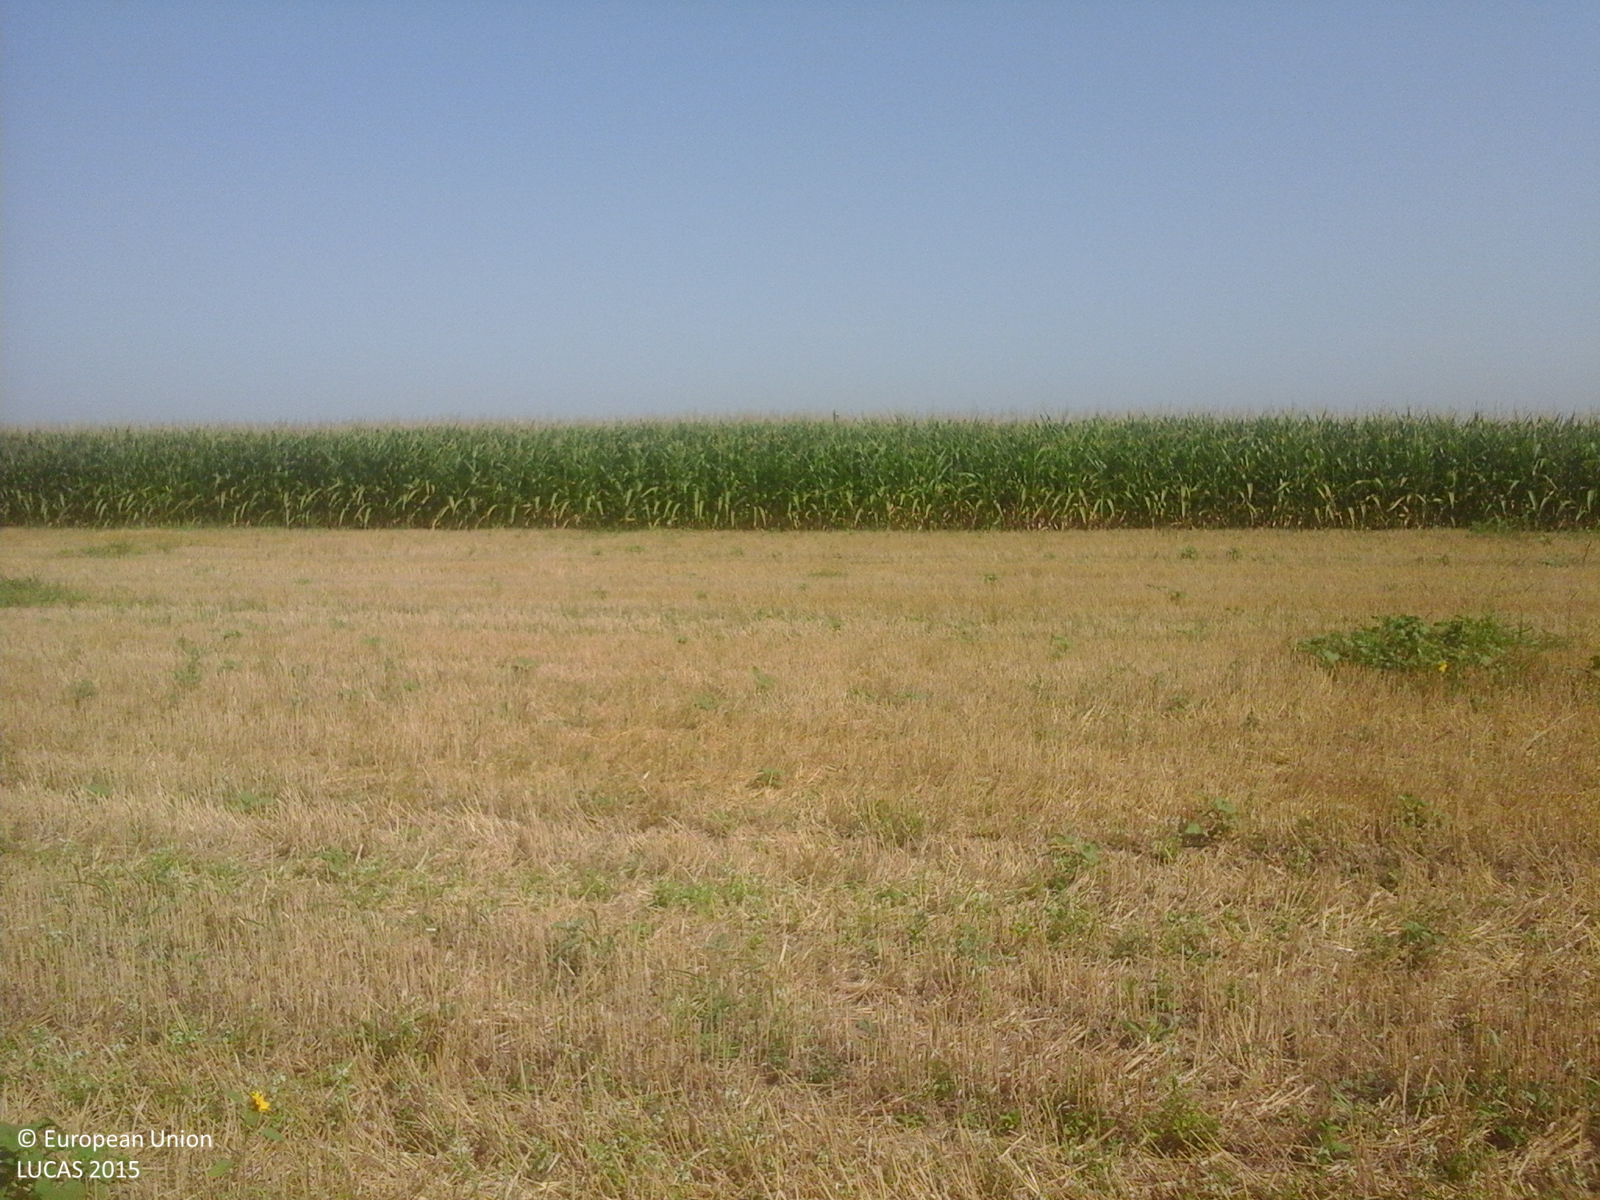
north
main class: Cropland
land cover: Maize
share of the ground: > 75 %
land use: Agriculture (excluding fallow land and kitchen gardens)
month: August
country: RO
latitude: 45.1423
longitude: 27.7716
